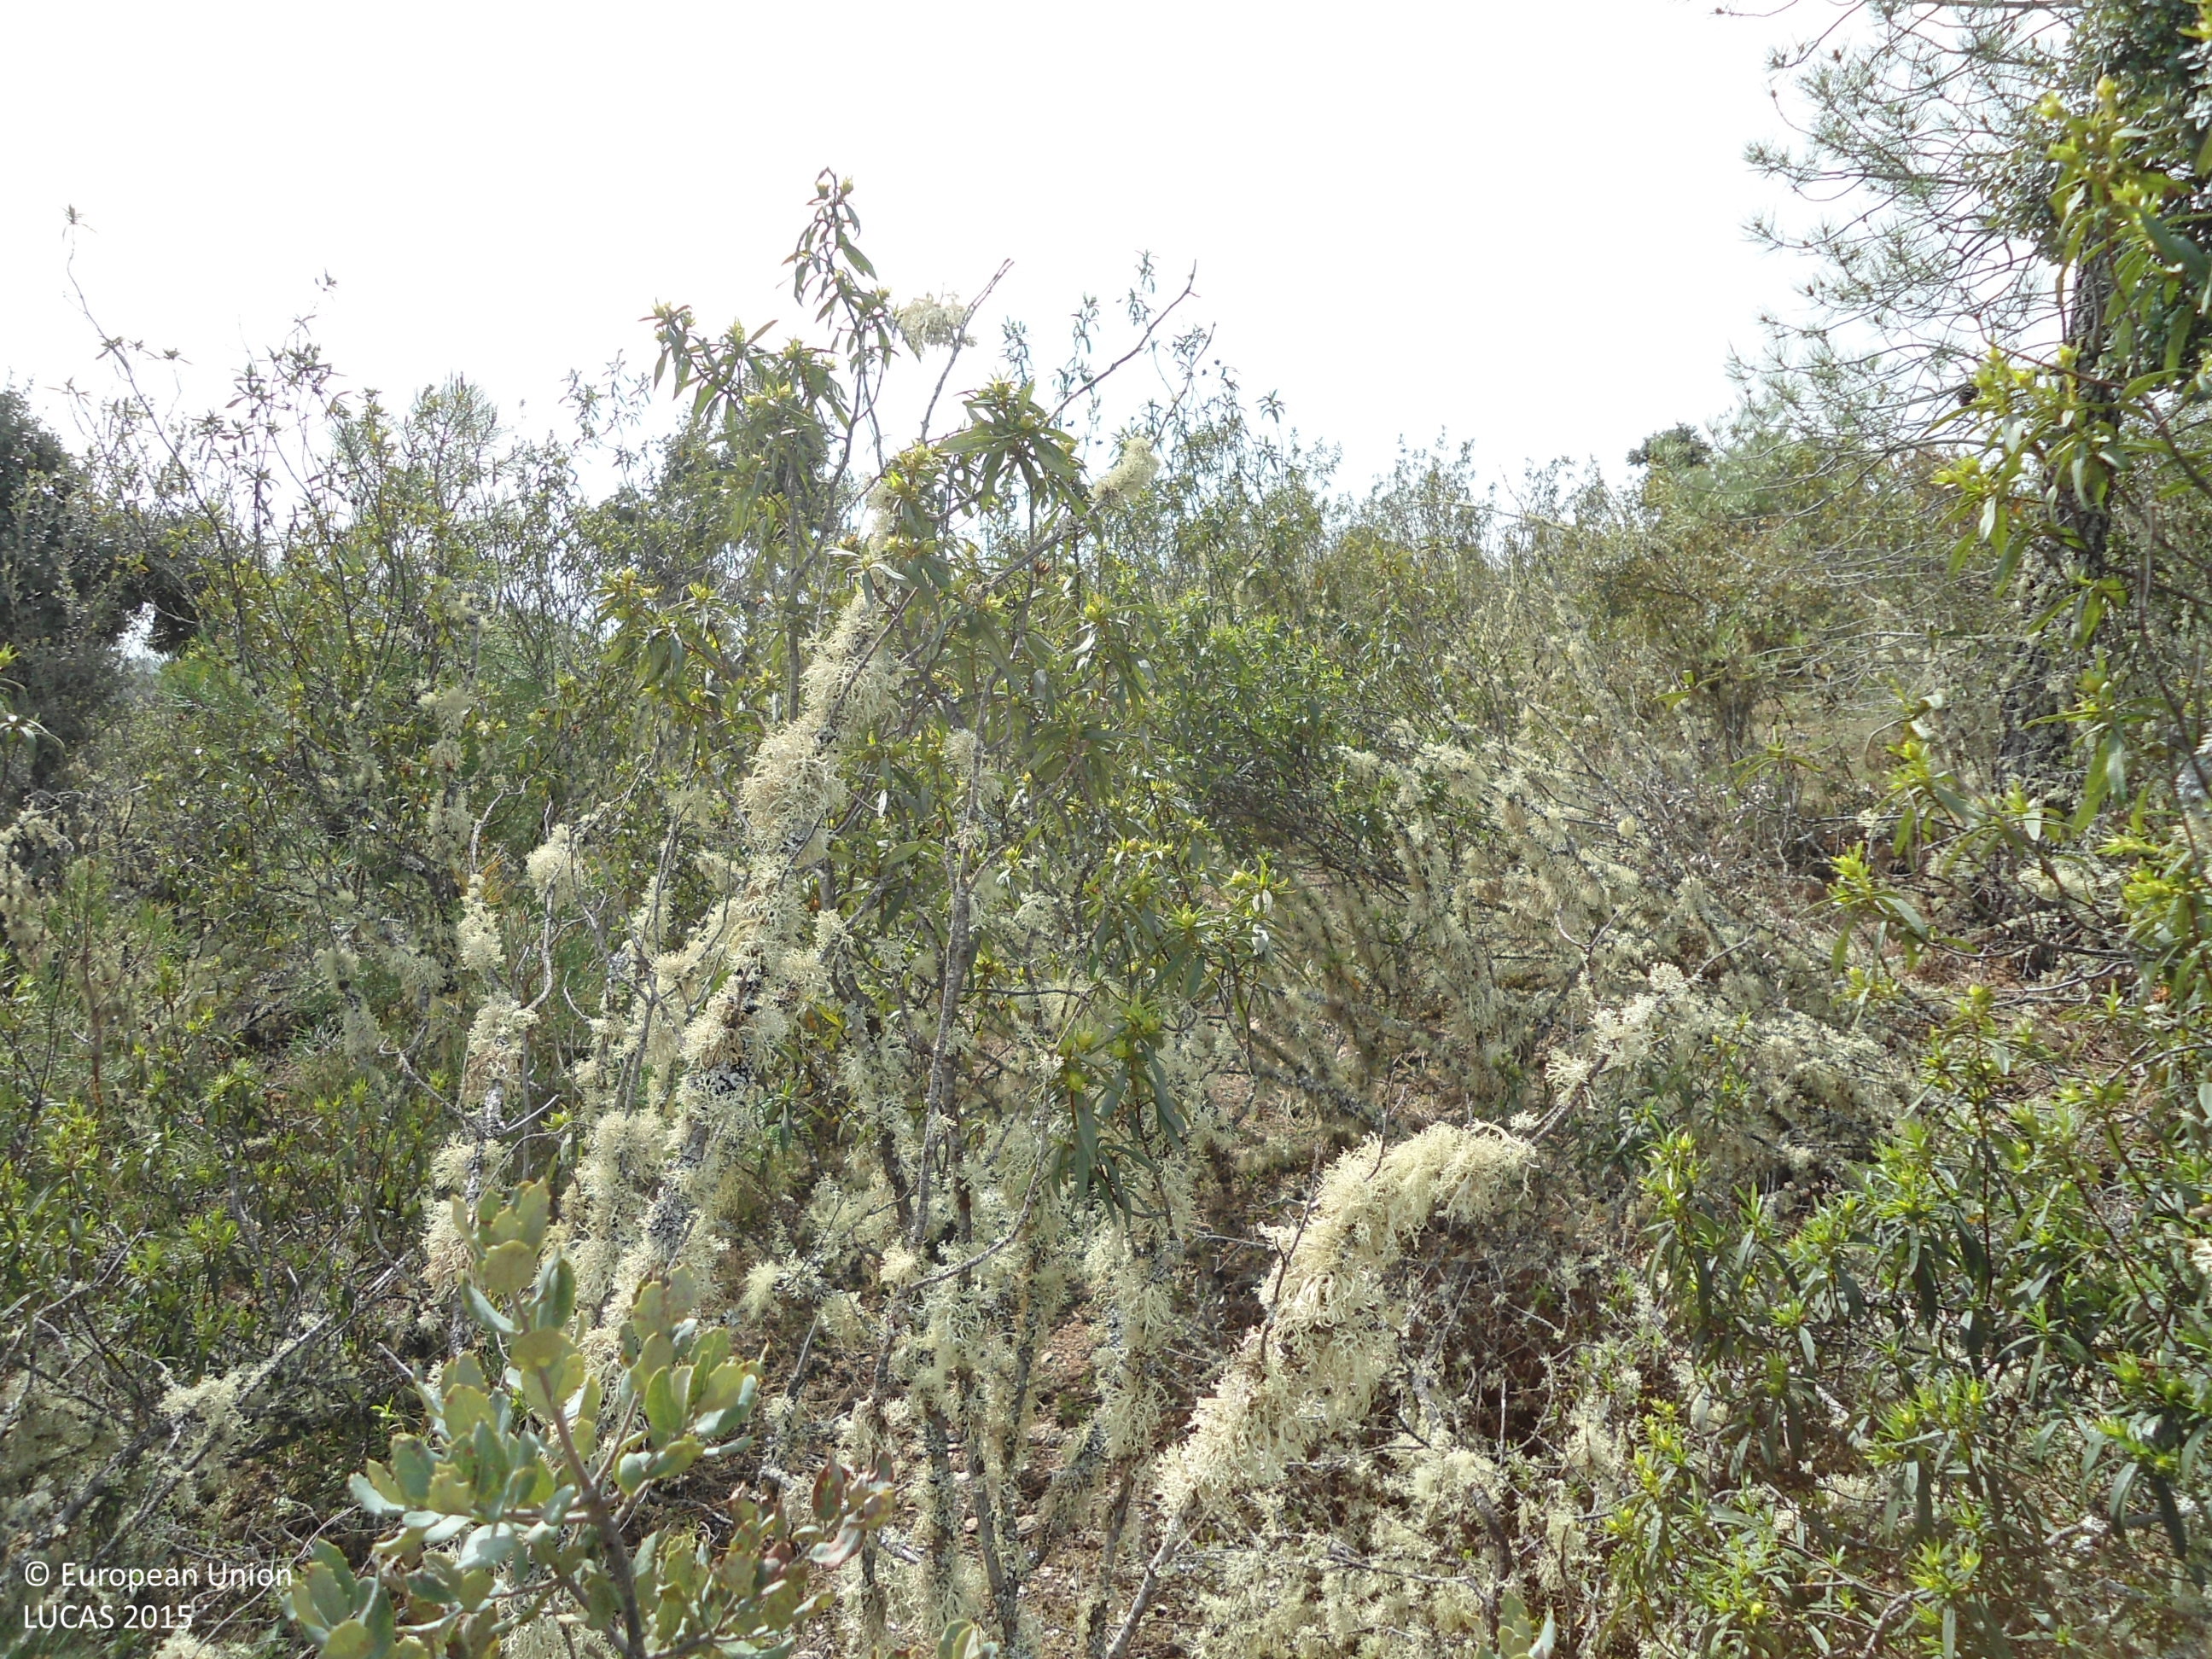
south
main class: Shrubland
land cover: Shrubland with sparse tree cover
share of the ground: > 75 %
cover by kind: shrubs 95 %, coniferous forest trees 5 %
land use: Forestry
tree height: < 5 m
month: April
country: ES
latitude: 41.8244
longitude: -6.4933
